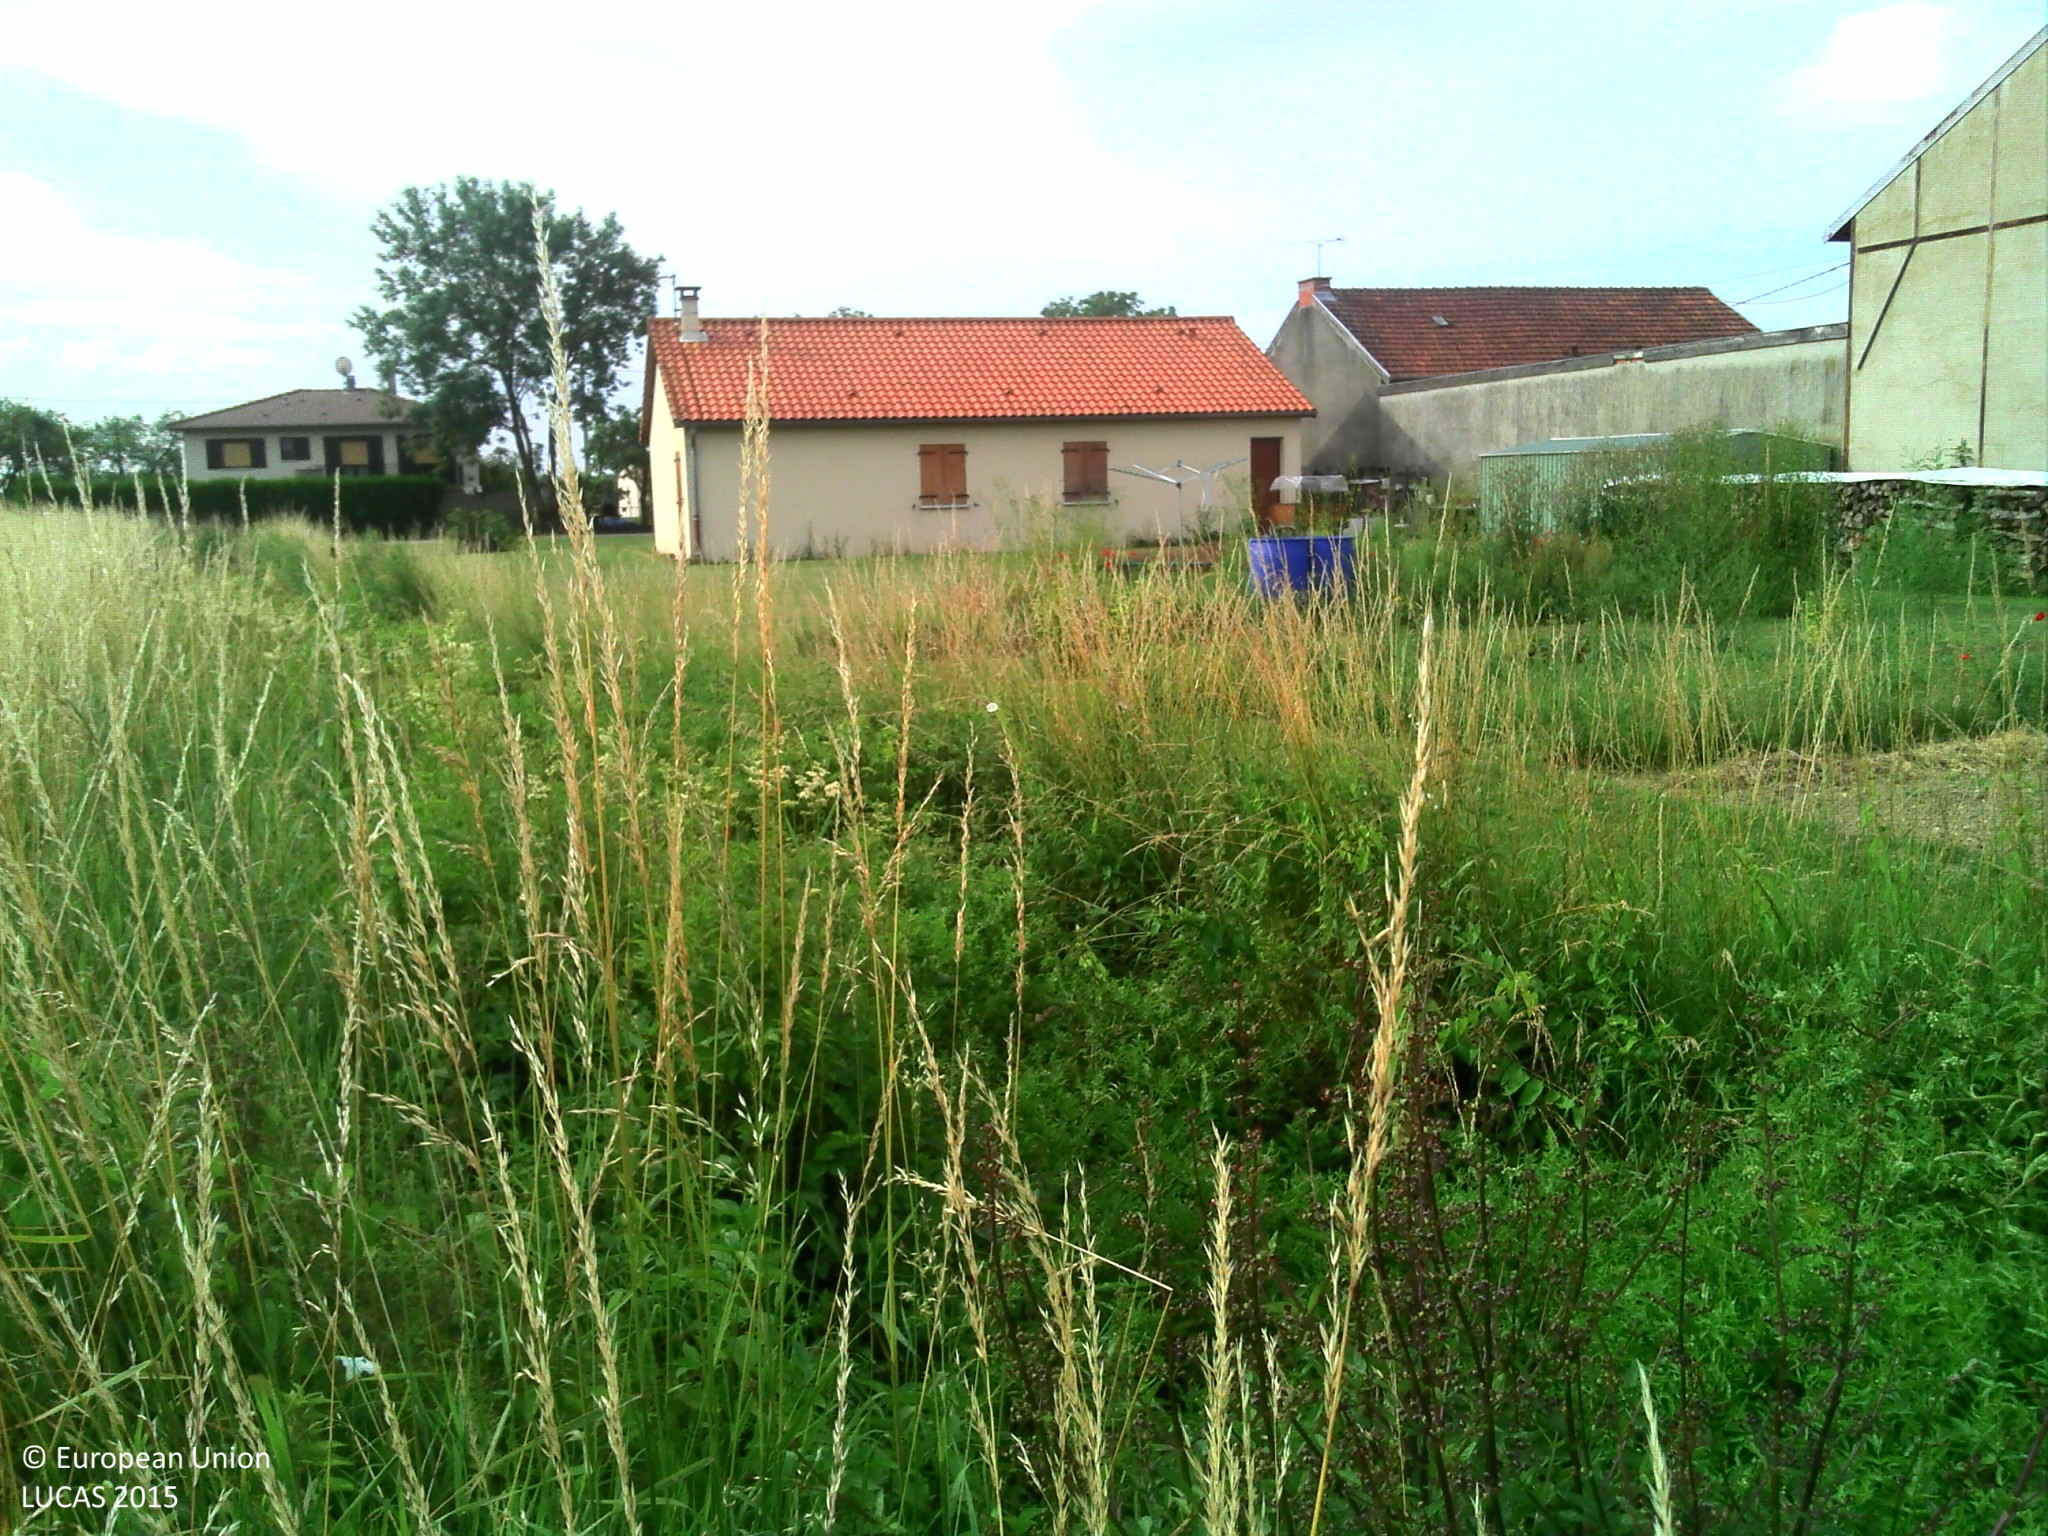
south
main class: Grassland
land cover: Grassland without tree/shrub cover
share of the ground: > 75 %
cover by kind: herbaceous plants 100 %
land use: Agriculture (excluding fallow land and kitchen gardens)
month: June
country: FR
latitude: 48.8274
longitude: 4.9169
